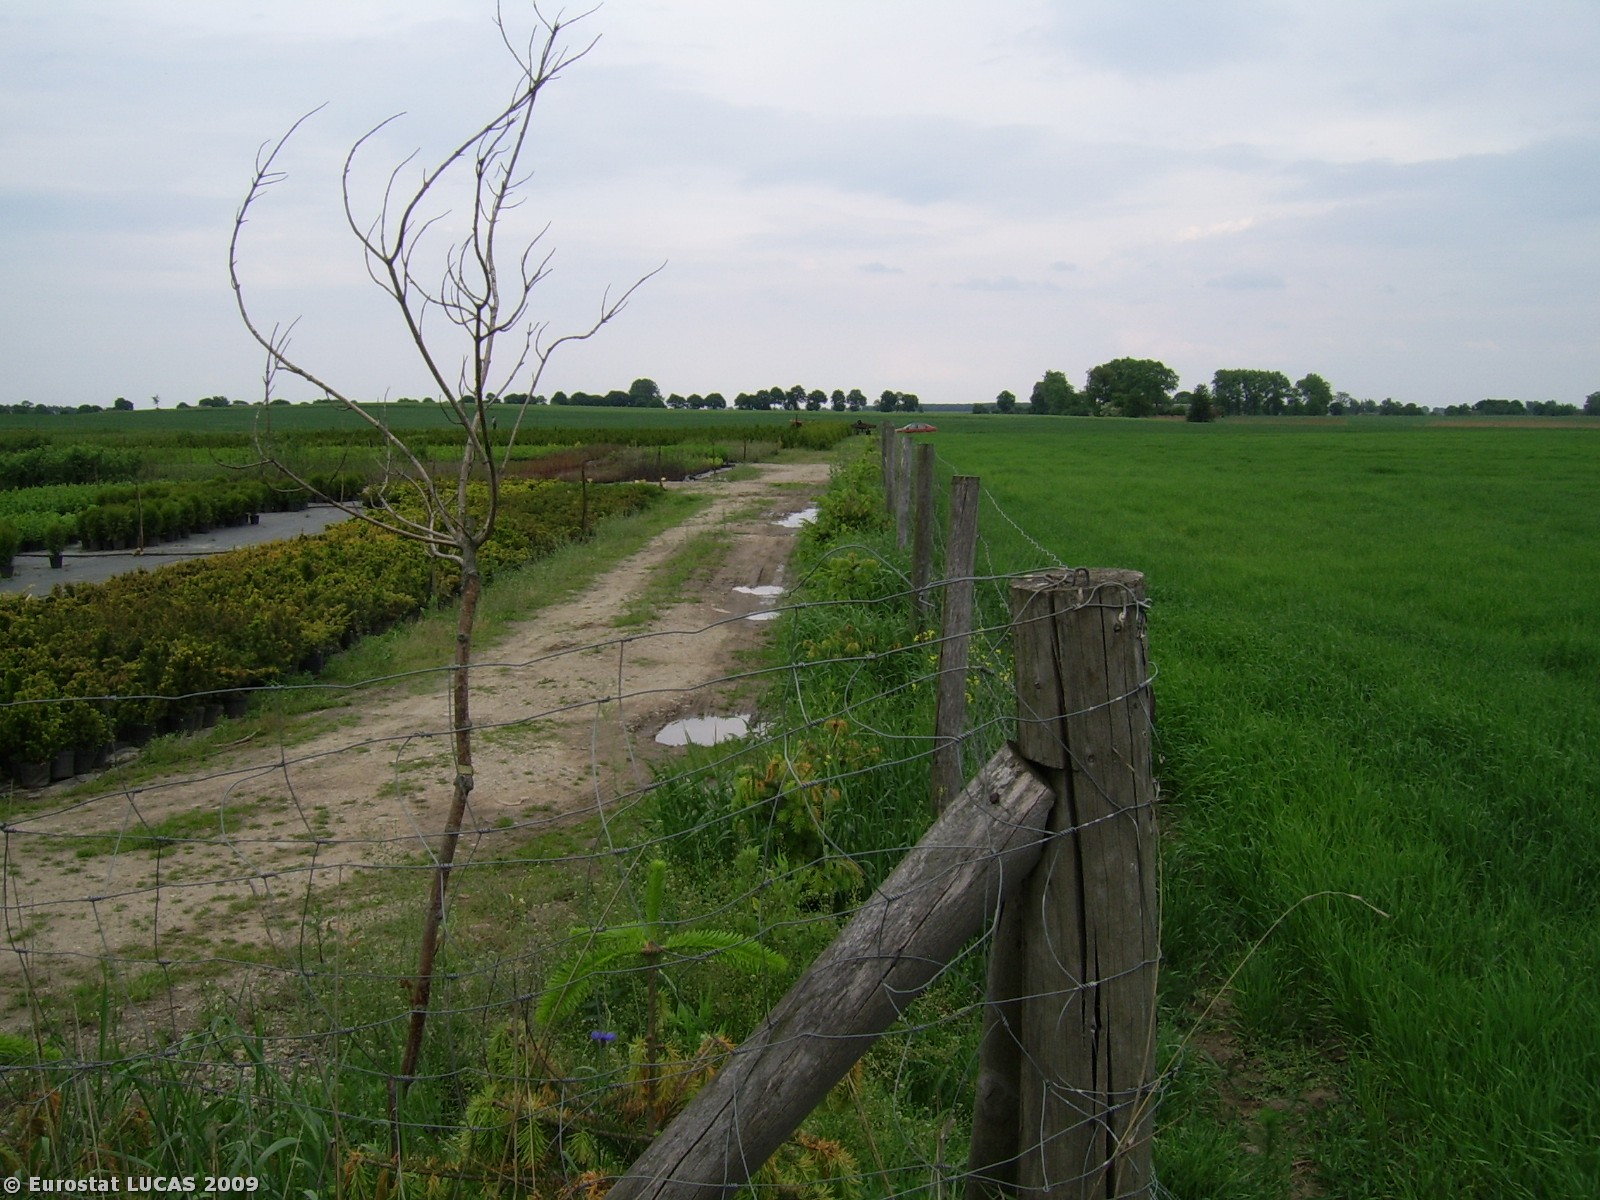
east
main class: Cropland
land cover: Rye
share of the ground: > 75 %
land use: Agriculture (excluding fallow land and kitchen gardens)
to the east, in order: Rye; Fences; Tracks; Nurseries; Electric lines; Nurseries; Fences; Grass margins; Bare land; Grass margins; Fences; Tracks; Nurseries
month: May
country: PL
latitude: 52.7238
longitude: 17.9661
